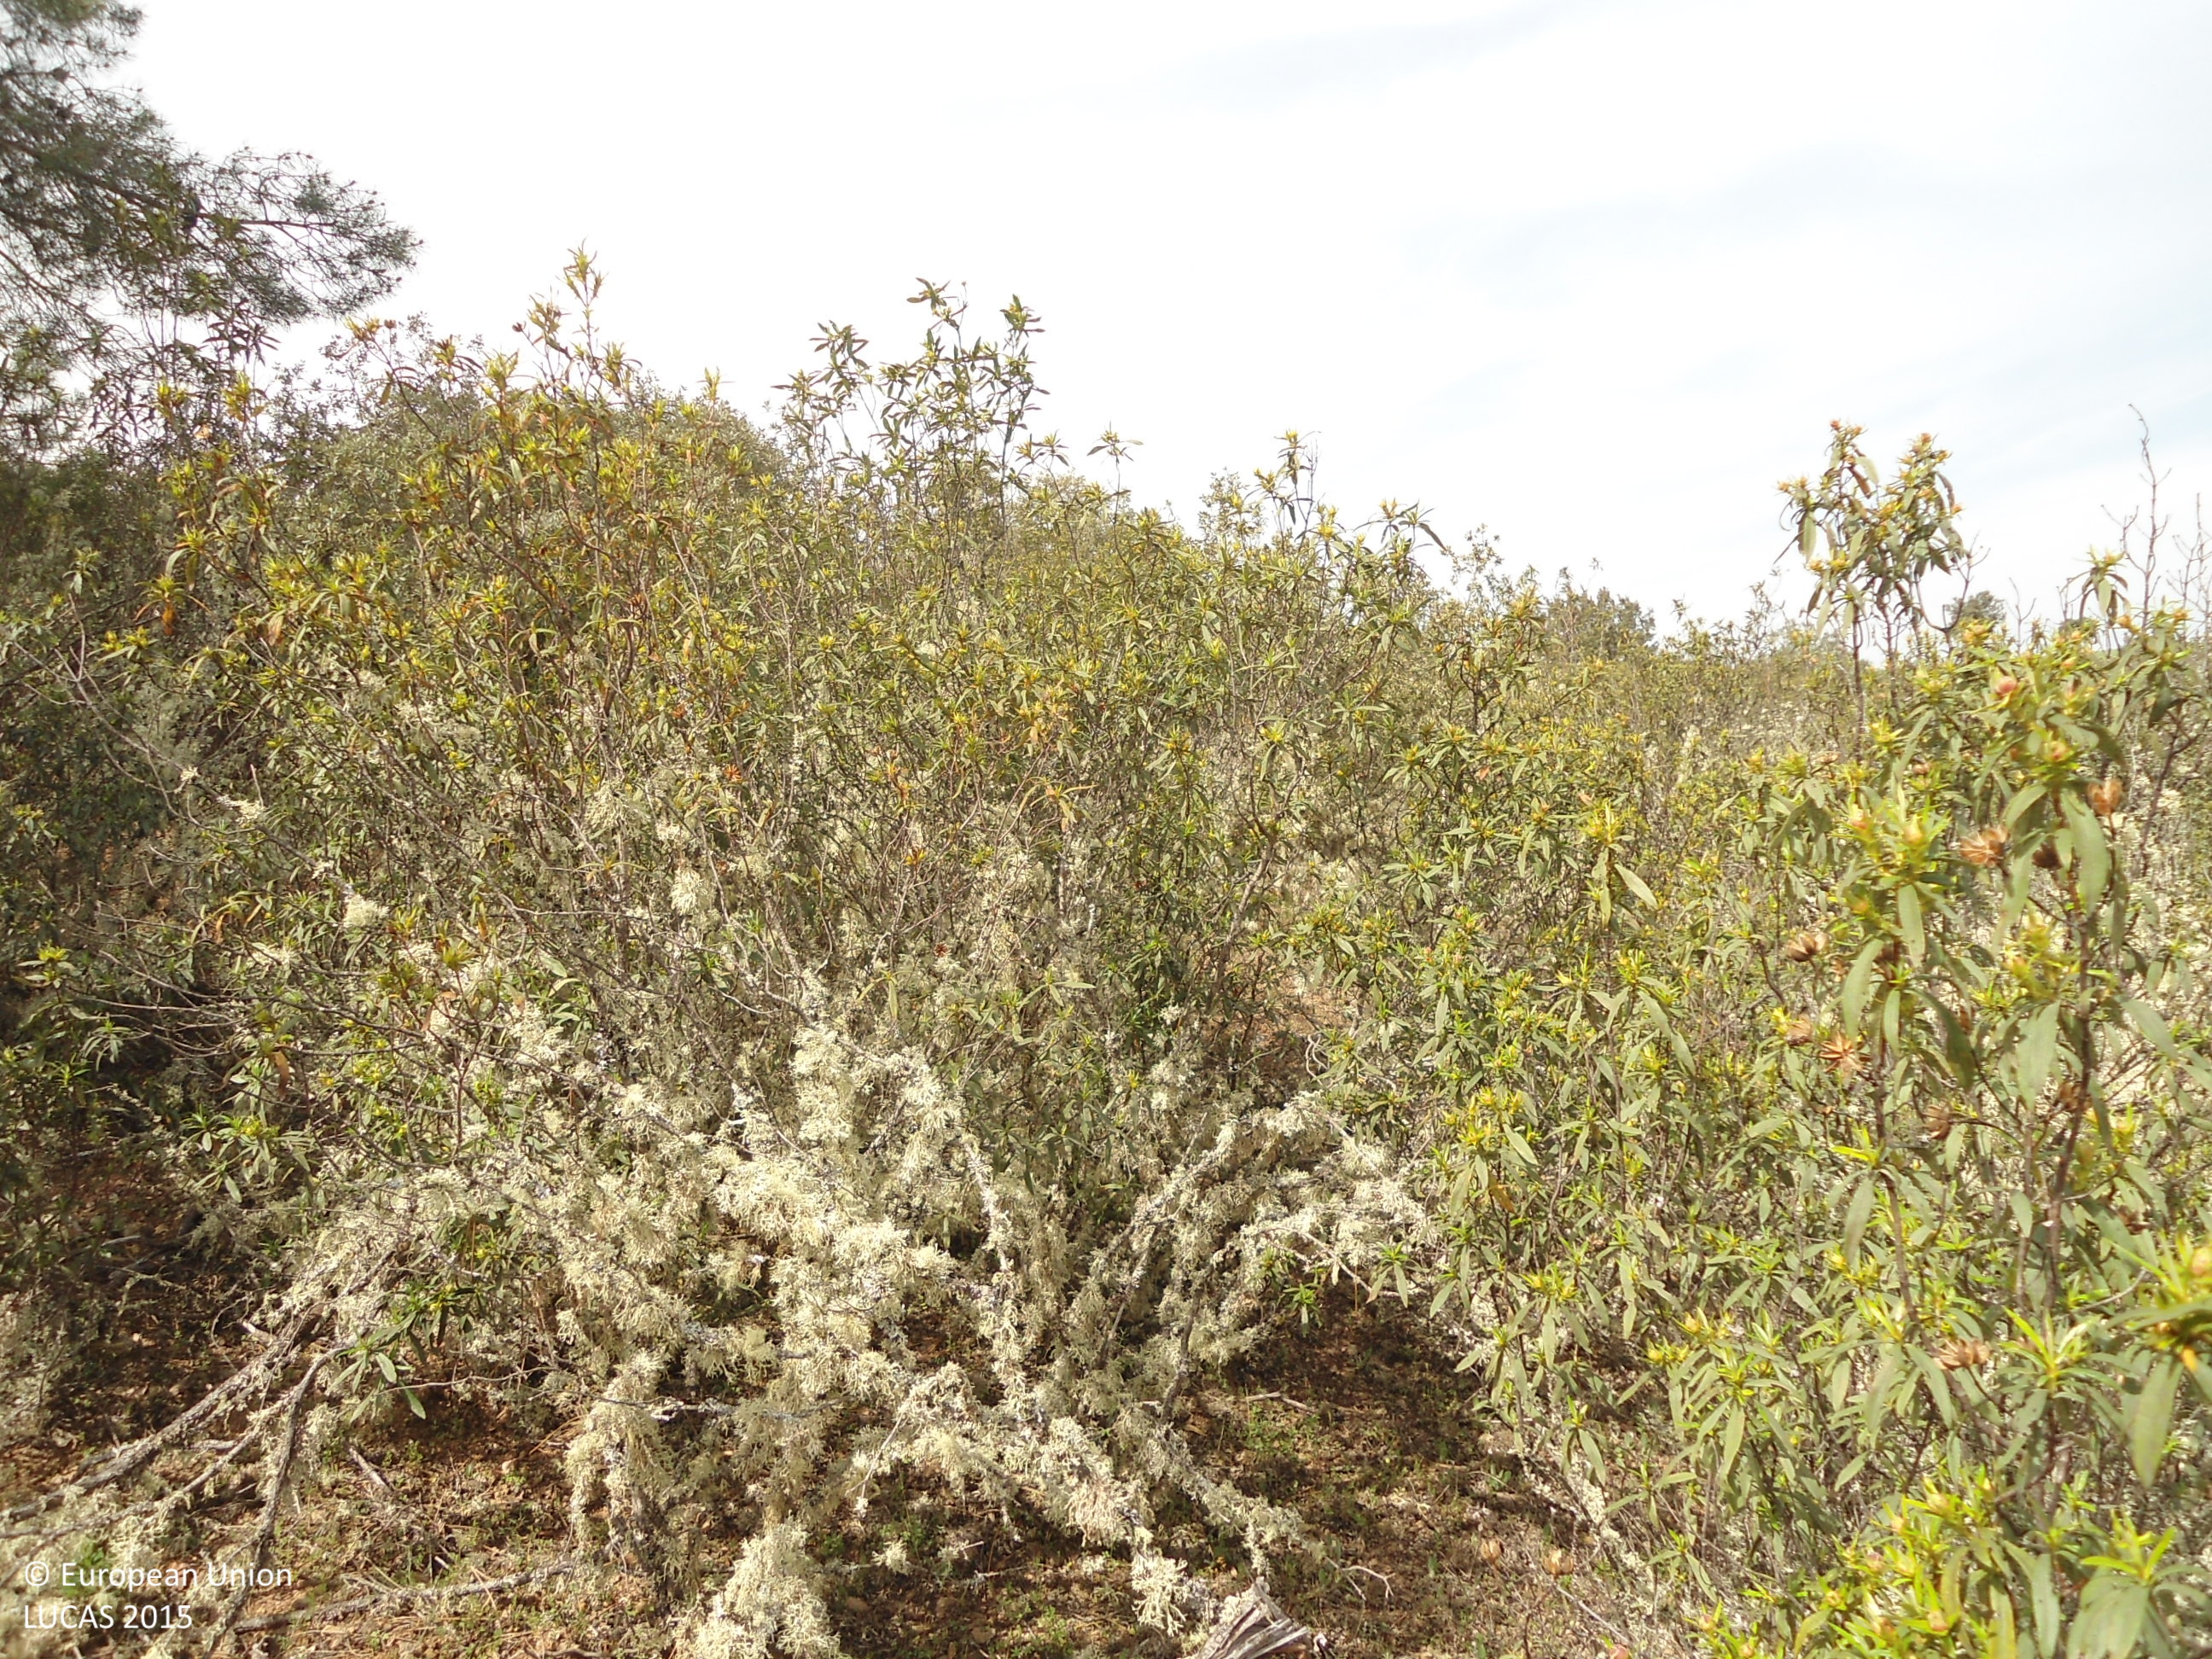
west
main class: Shrubland
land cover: Shrubland with sparse tree cover
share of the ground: > 75 %
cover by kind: shrubs 95 %, coniferous forest trees 5 %
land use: Forestry
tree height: < 5 m
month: April
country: ES
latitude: 41.8244
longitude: -6.4933
